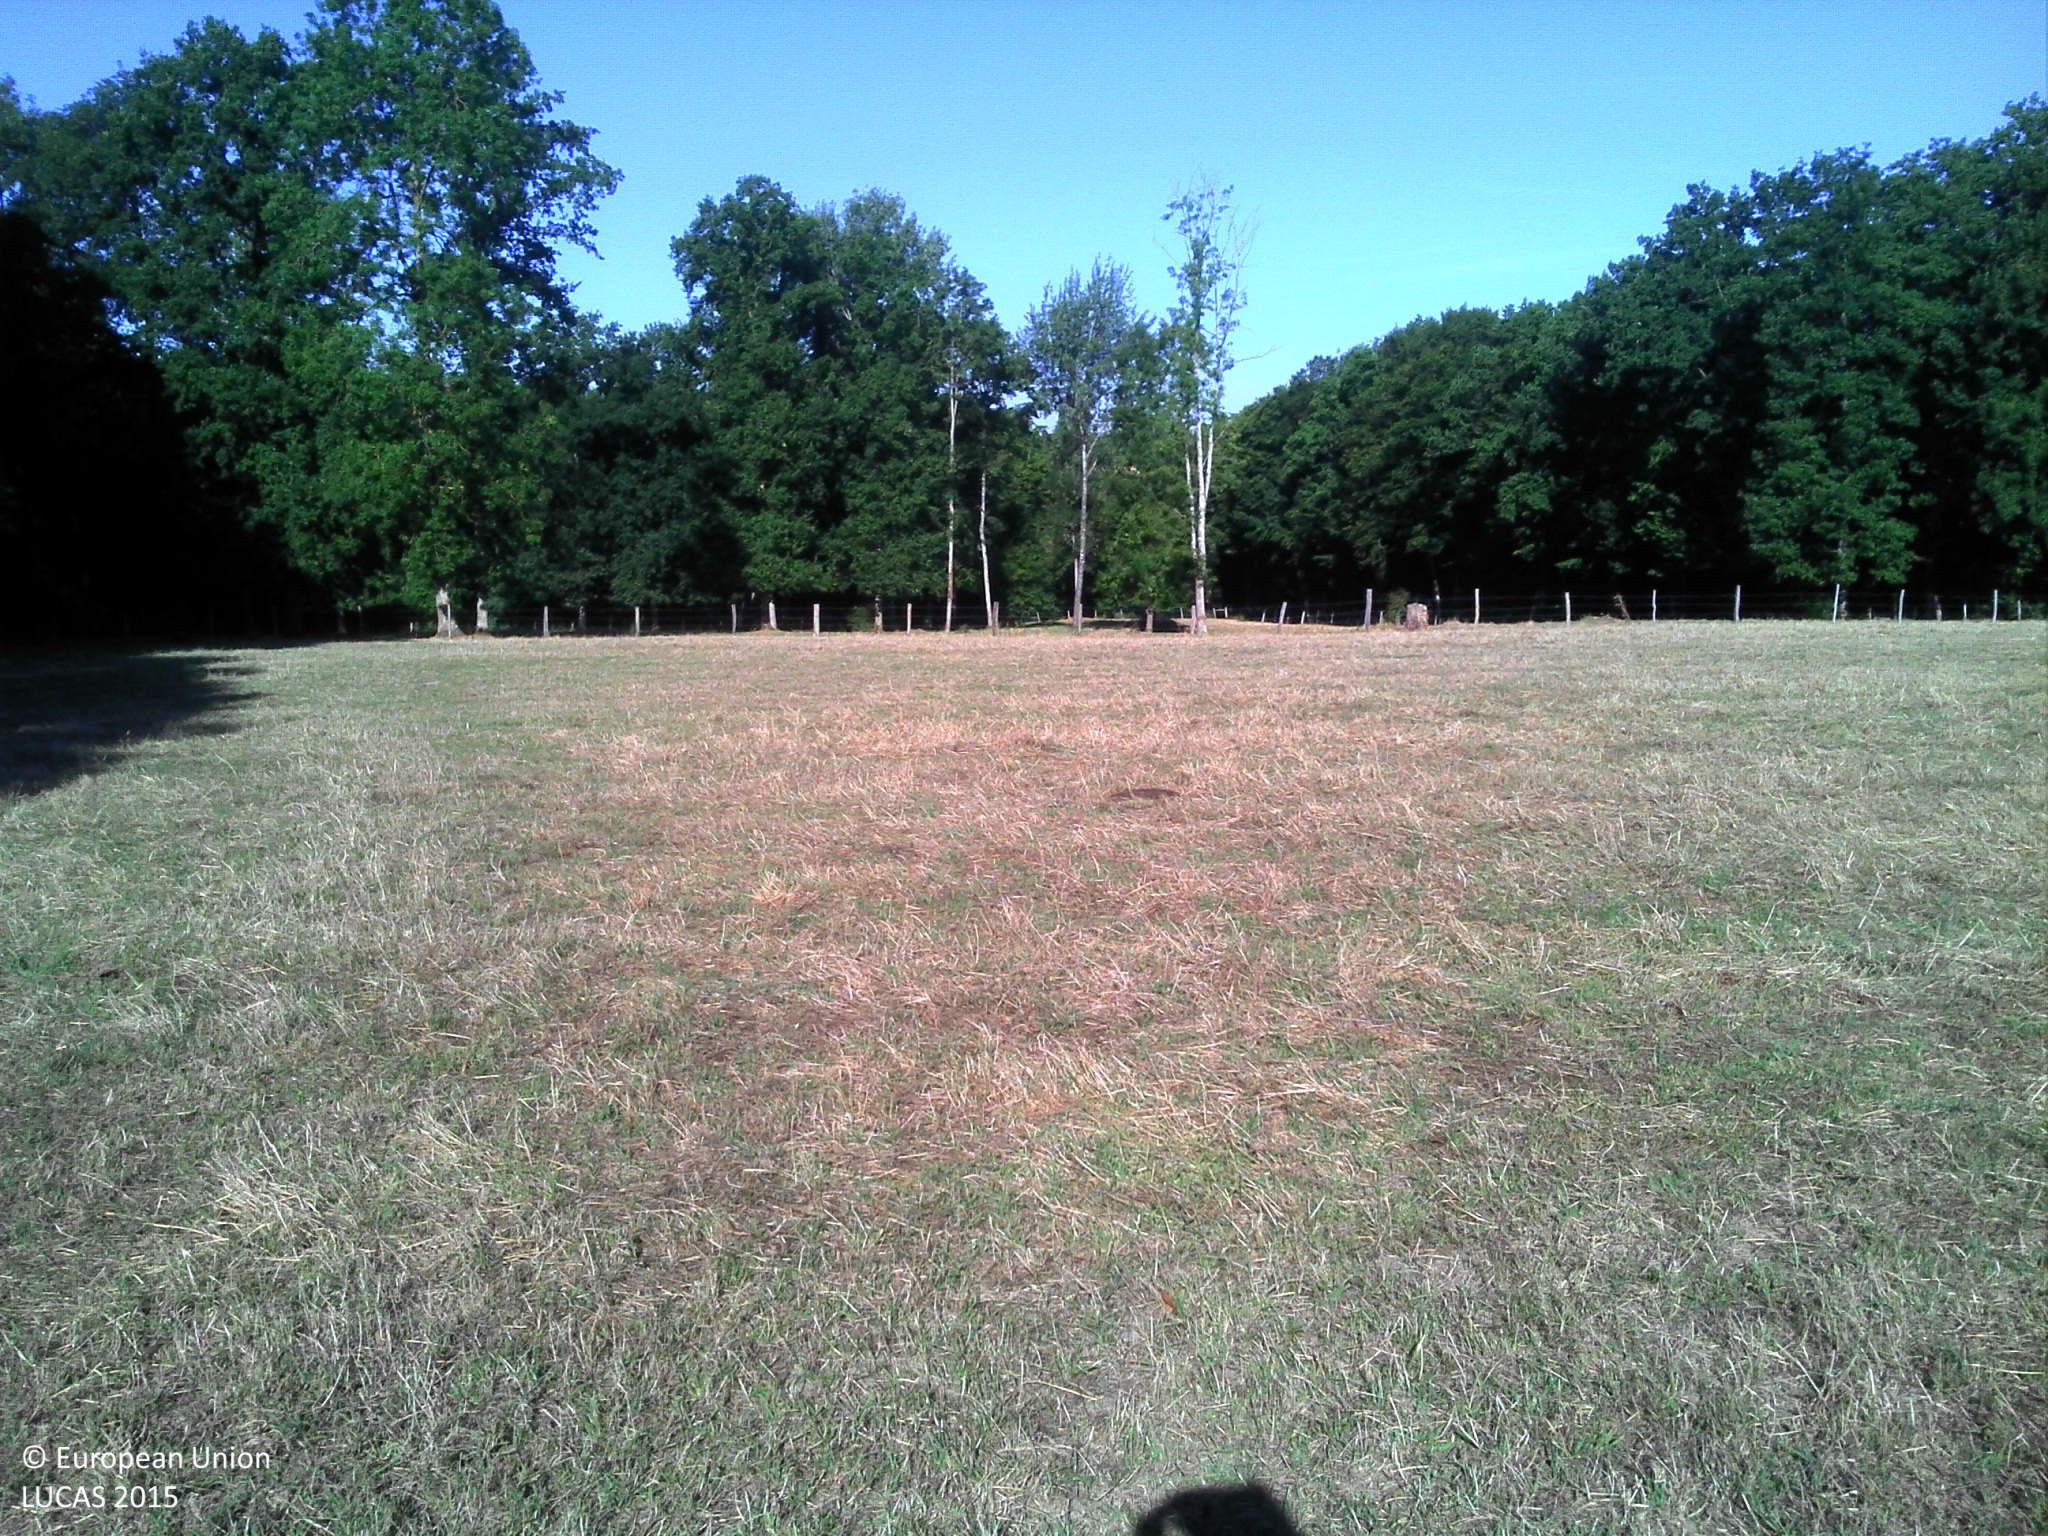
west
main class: Grassland
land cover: Grassland without tree/shrub cover
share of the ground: > 75 %
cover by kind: herbaceous plants 85 %, lichens and mosses 10 %, unconsolidated bare surface 5 %
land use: Agriculture (excluding fallow land and kitchen gardens)
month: August
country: FR
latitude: 48.8030
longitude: 3.4171
